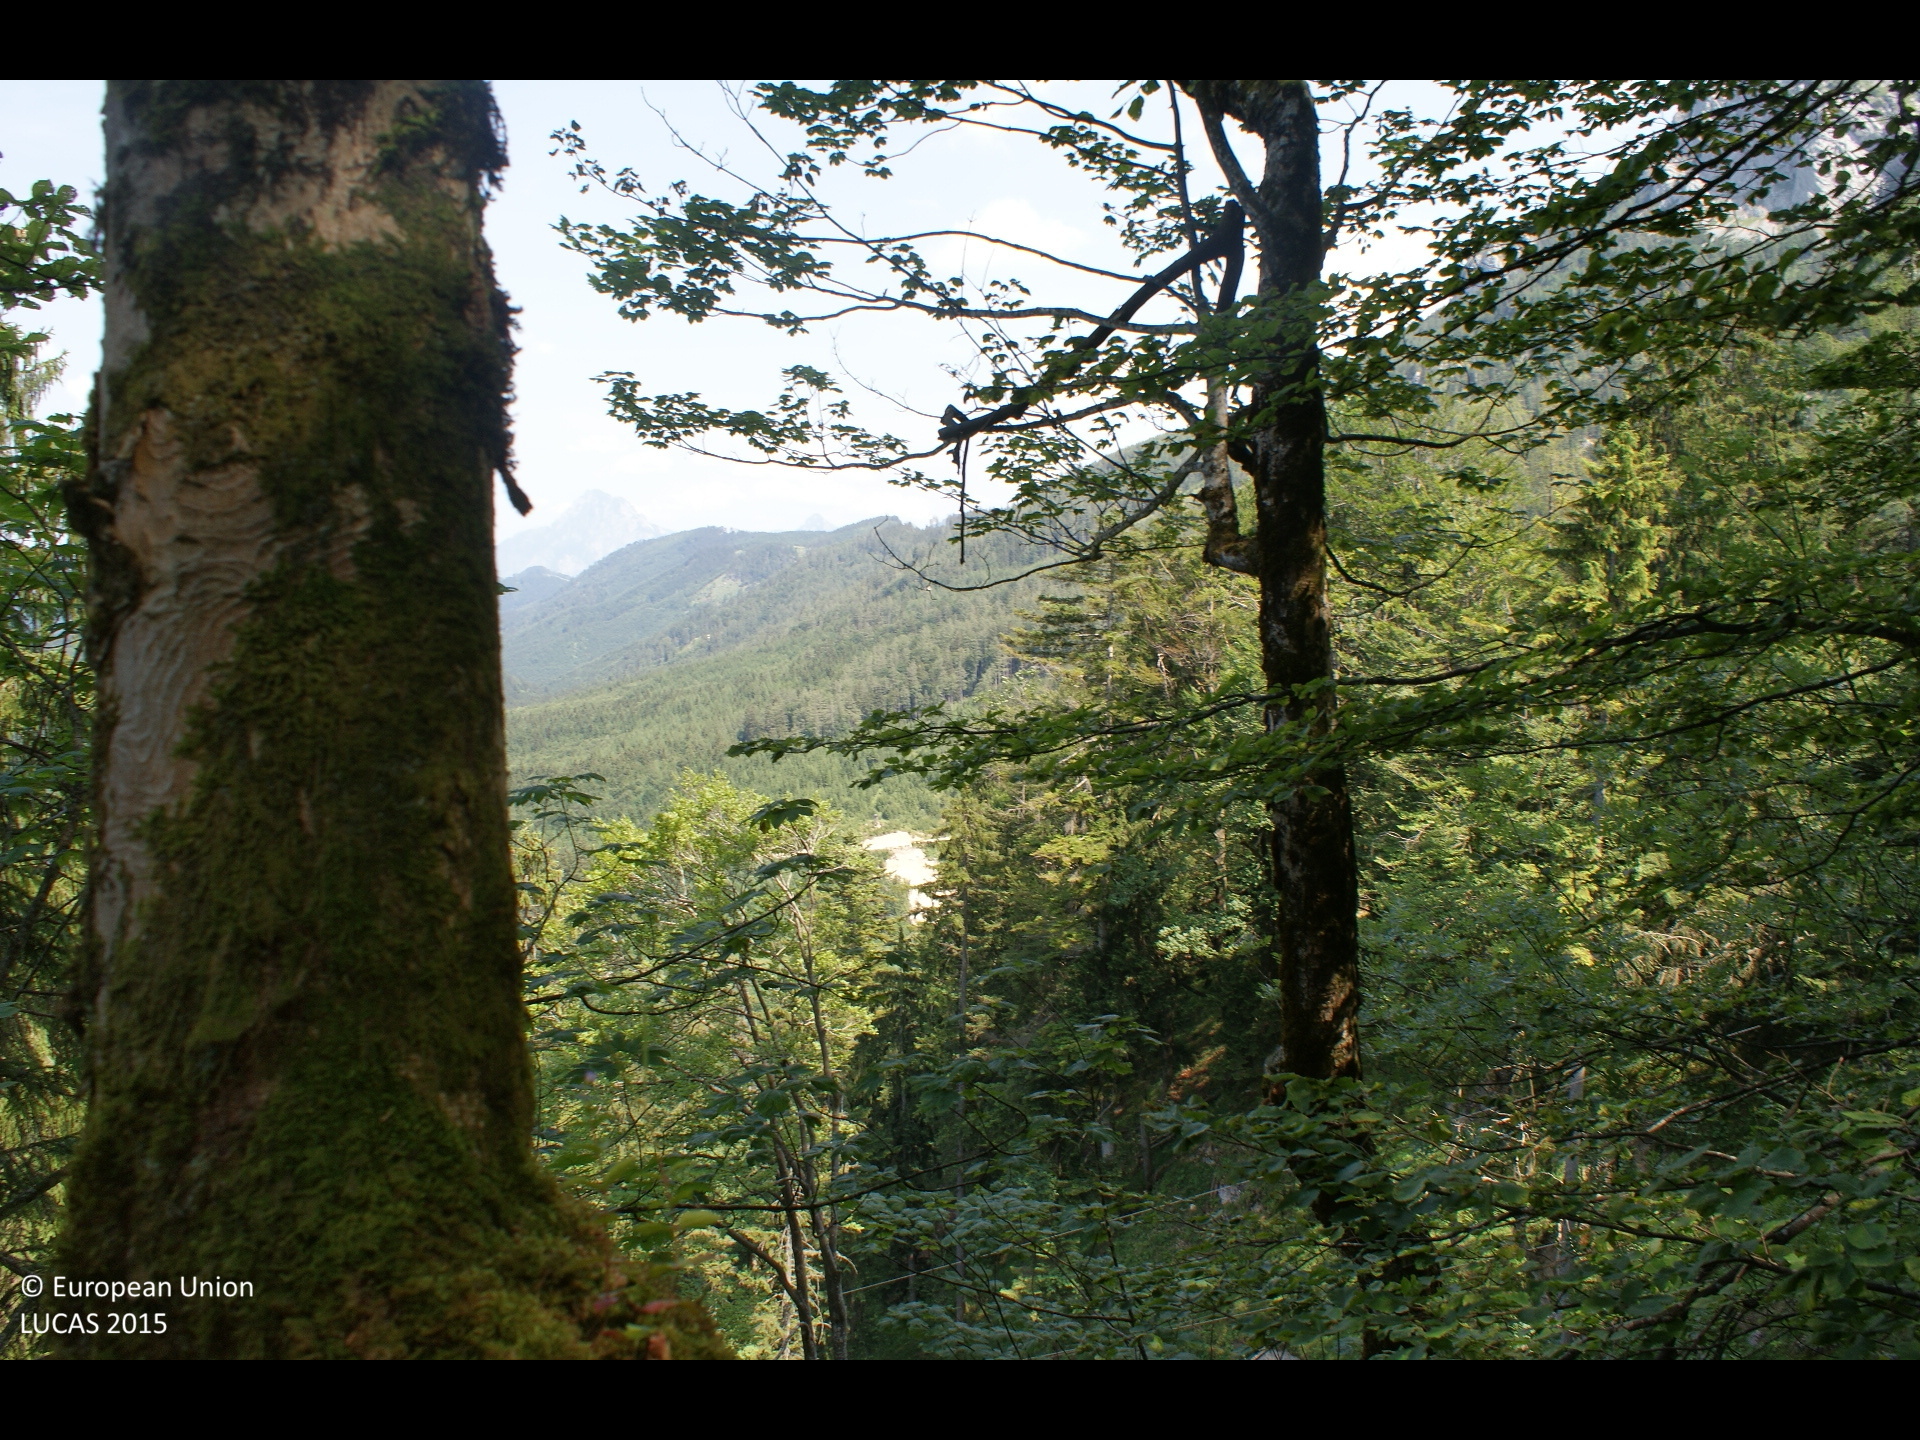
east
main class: Woodland
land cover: Spruce dominated mixed woodland
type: beech forest
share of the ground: > 75 %
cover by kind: broadleaved forest trees 60 %, coniferous forest trees 25 %, shrubs 5 %, herbaceous plants 5 %, consolidated bare surface 5 %
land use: Forestry
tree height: > 5 m
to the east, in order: Spruce dominated mixed woodland; Grassland with sparse tree/shrub cover; Electric lines; Grassland with sparse tree/shrub cover; Rivers and streams; Spruce dominated mixed woodland; Spruce dominated coniferous woodland; Spruce dominated mixed woodland; Rivers and streams; Spruce dominated mixed woodland
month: July
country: AT
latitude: 47.8399
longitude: 13.6198
